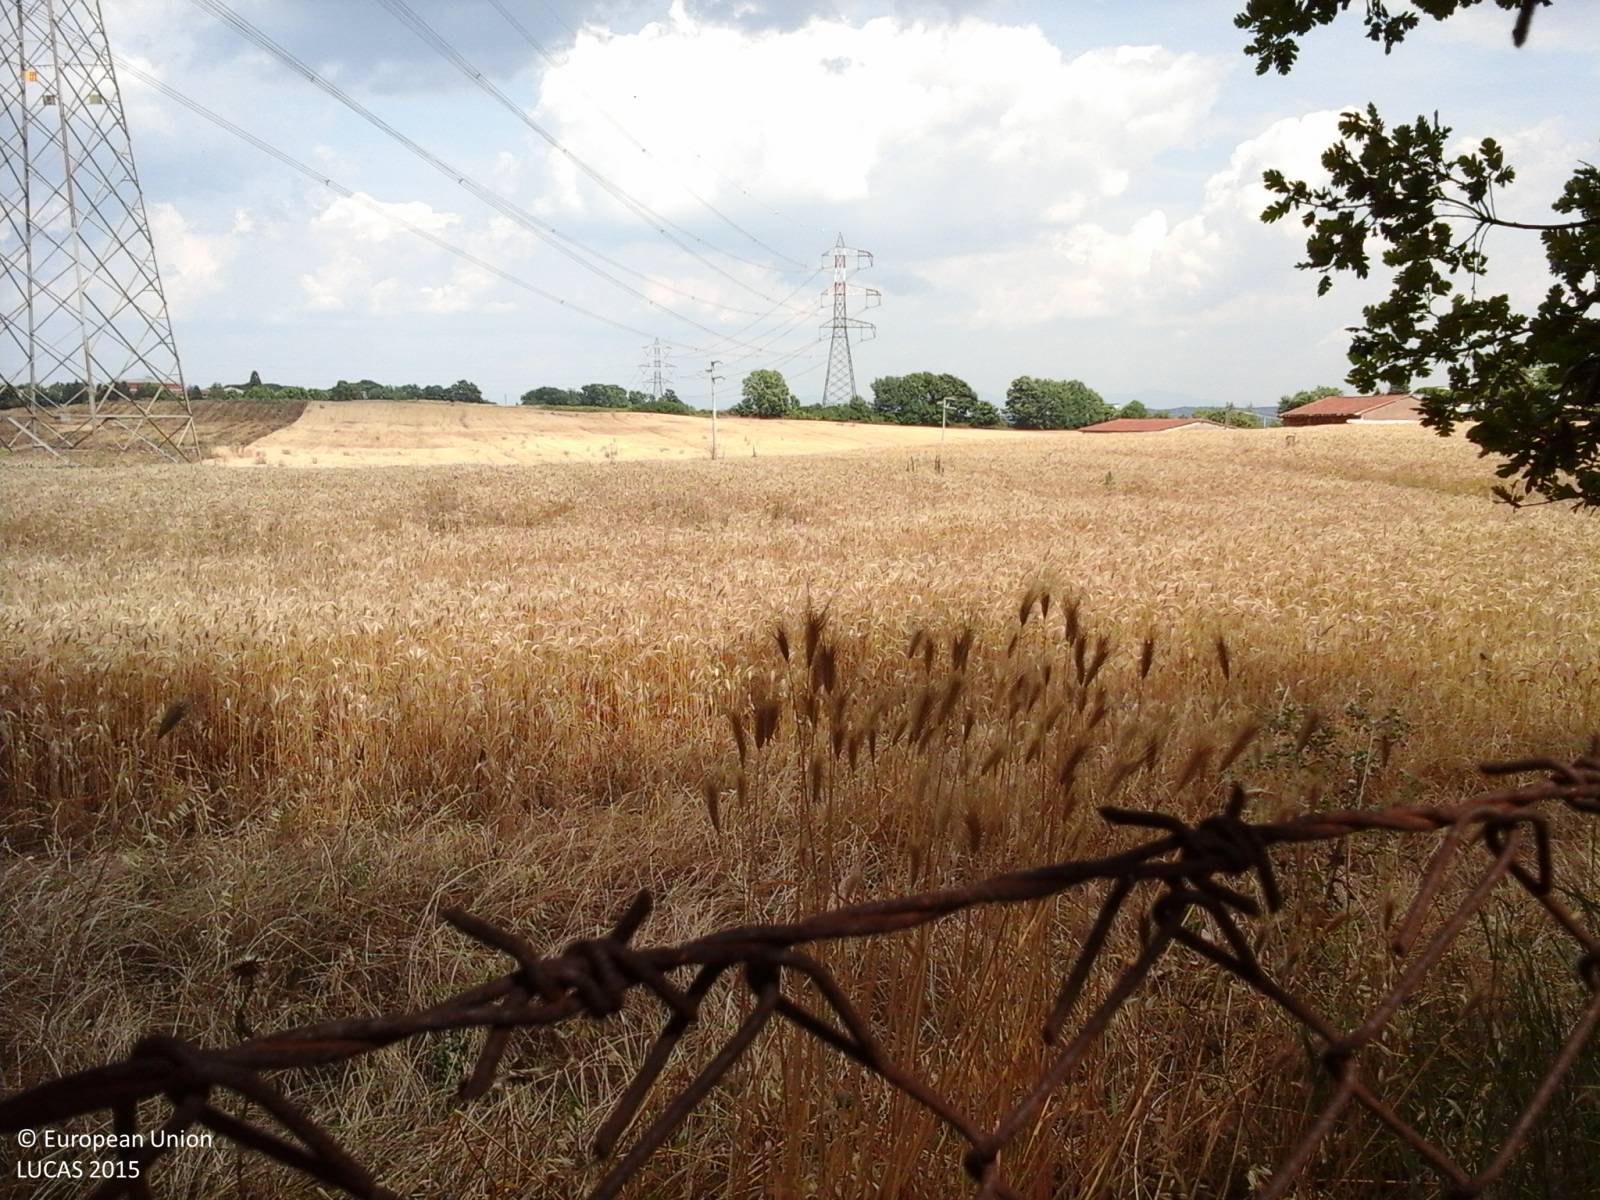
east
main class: Cropland
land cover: Durum wheat
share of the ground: > 75 %
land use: Agriculture (excluding fallow land and kitchen gardens)
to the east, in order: Durum wheat; Electric lines; Durum wheat; Managed hedges; Fences; Grassland without tree/shrub cover
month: June
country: IT
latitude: 42.1755
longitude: 12.3282
